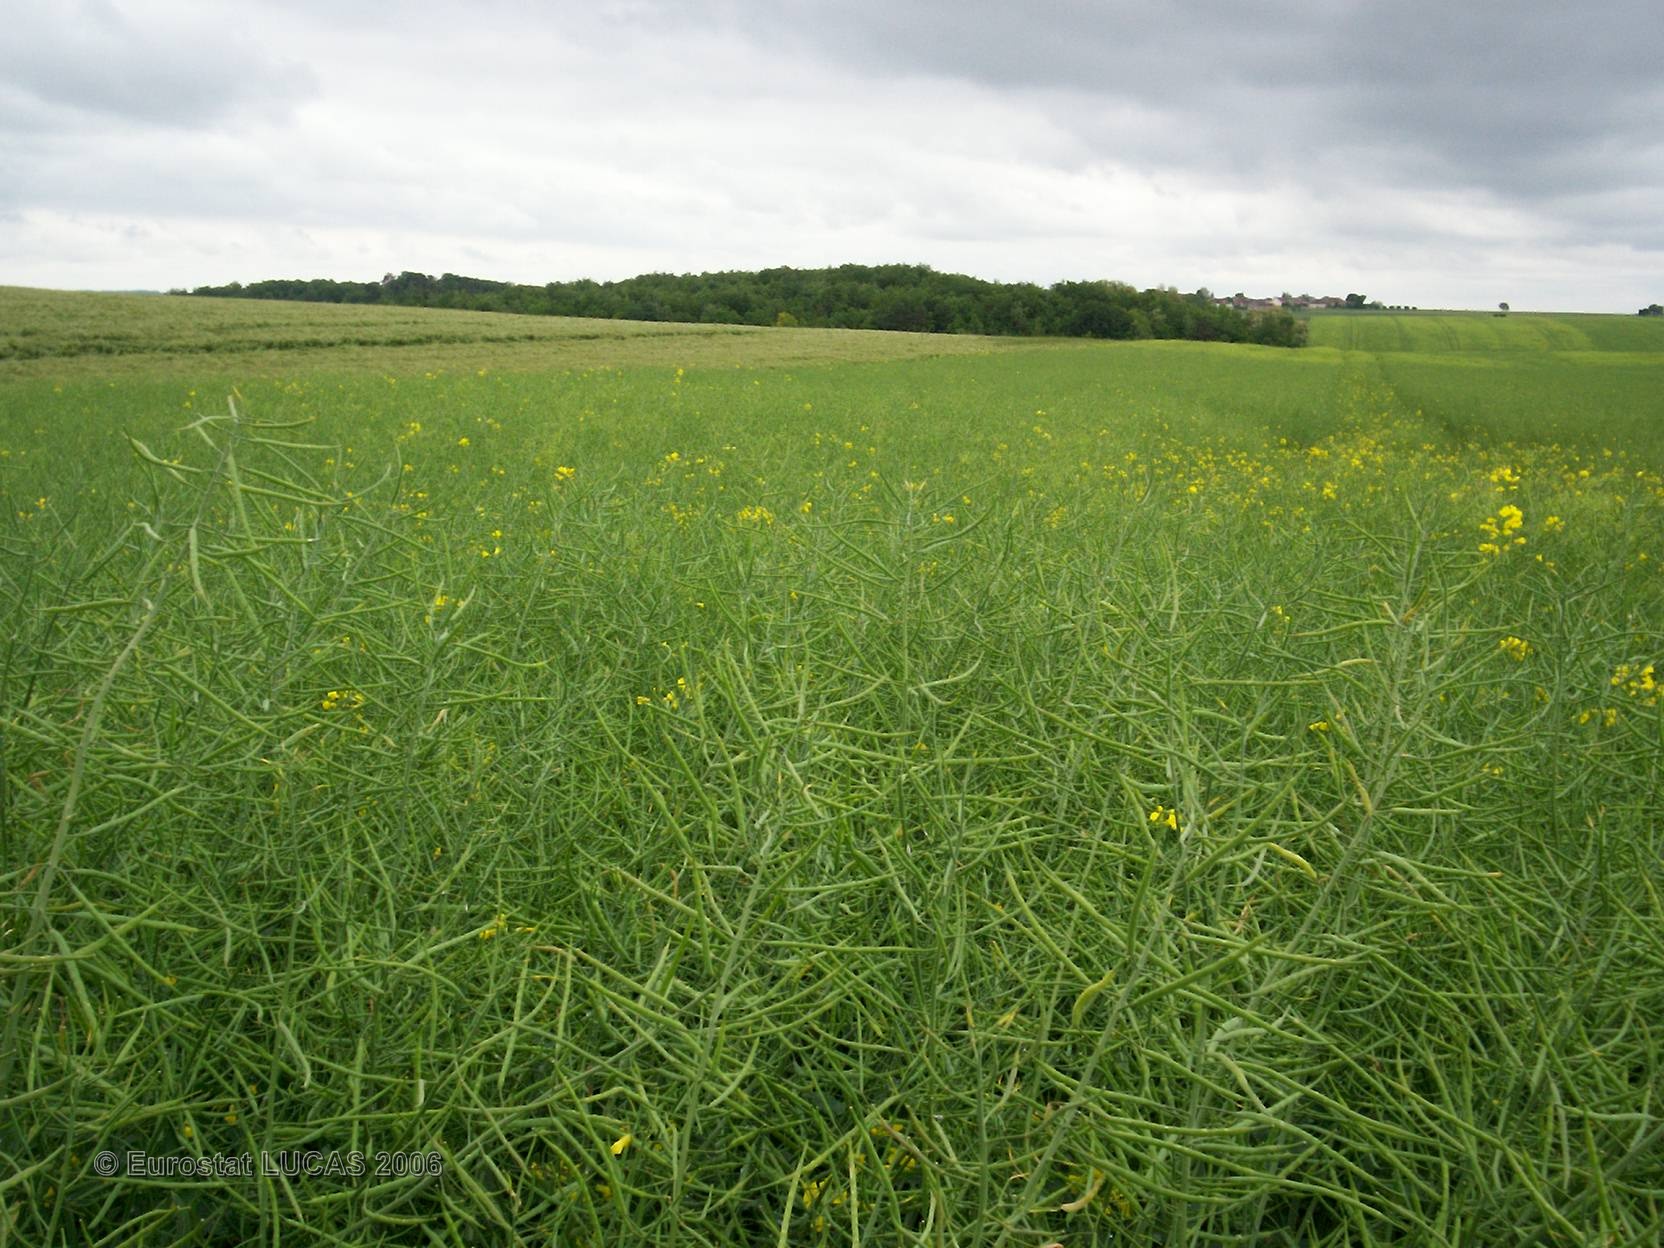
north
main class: Cropland
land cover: Rape and turnip rape
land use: Agriculture (excluding fallow land and kitchen gardens)
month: May
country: FR
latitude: 48.1969
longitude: 4.5491
